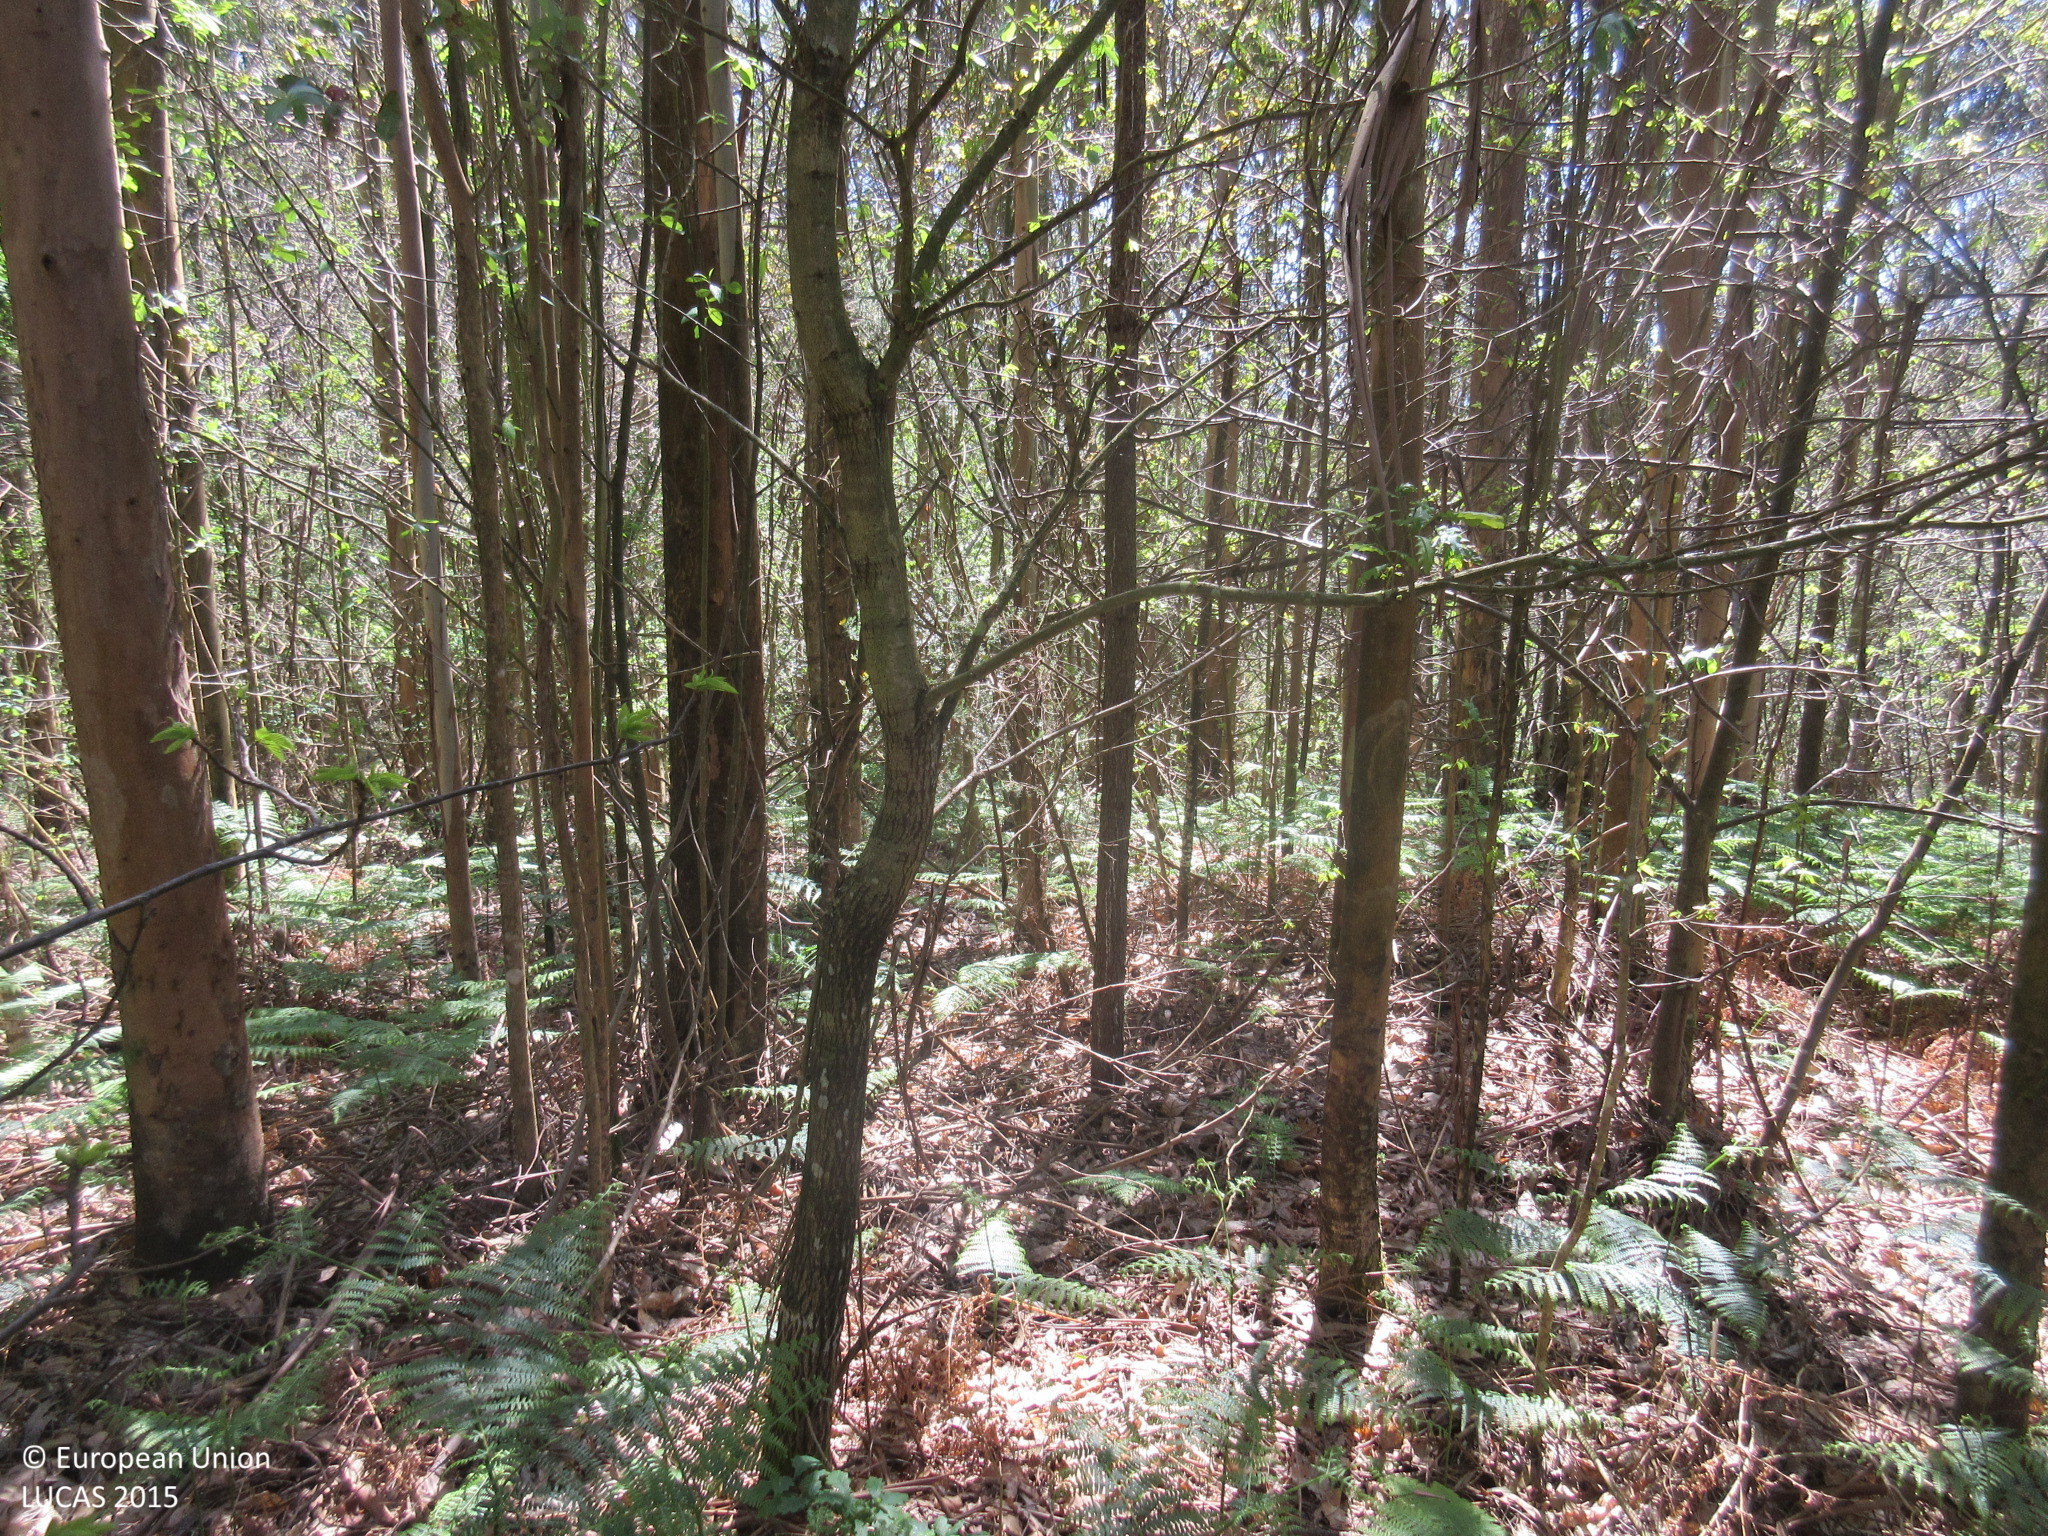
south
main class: Woodland
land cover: Broadleaved woodland
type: exotic forest
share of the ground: > 75 %
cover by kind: broadleaved forest trees 95 %, shrubs 5 %
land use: Forestry
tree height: > 5 m
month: April
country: ES
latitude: 43.4840
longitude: -7.0196
